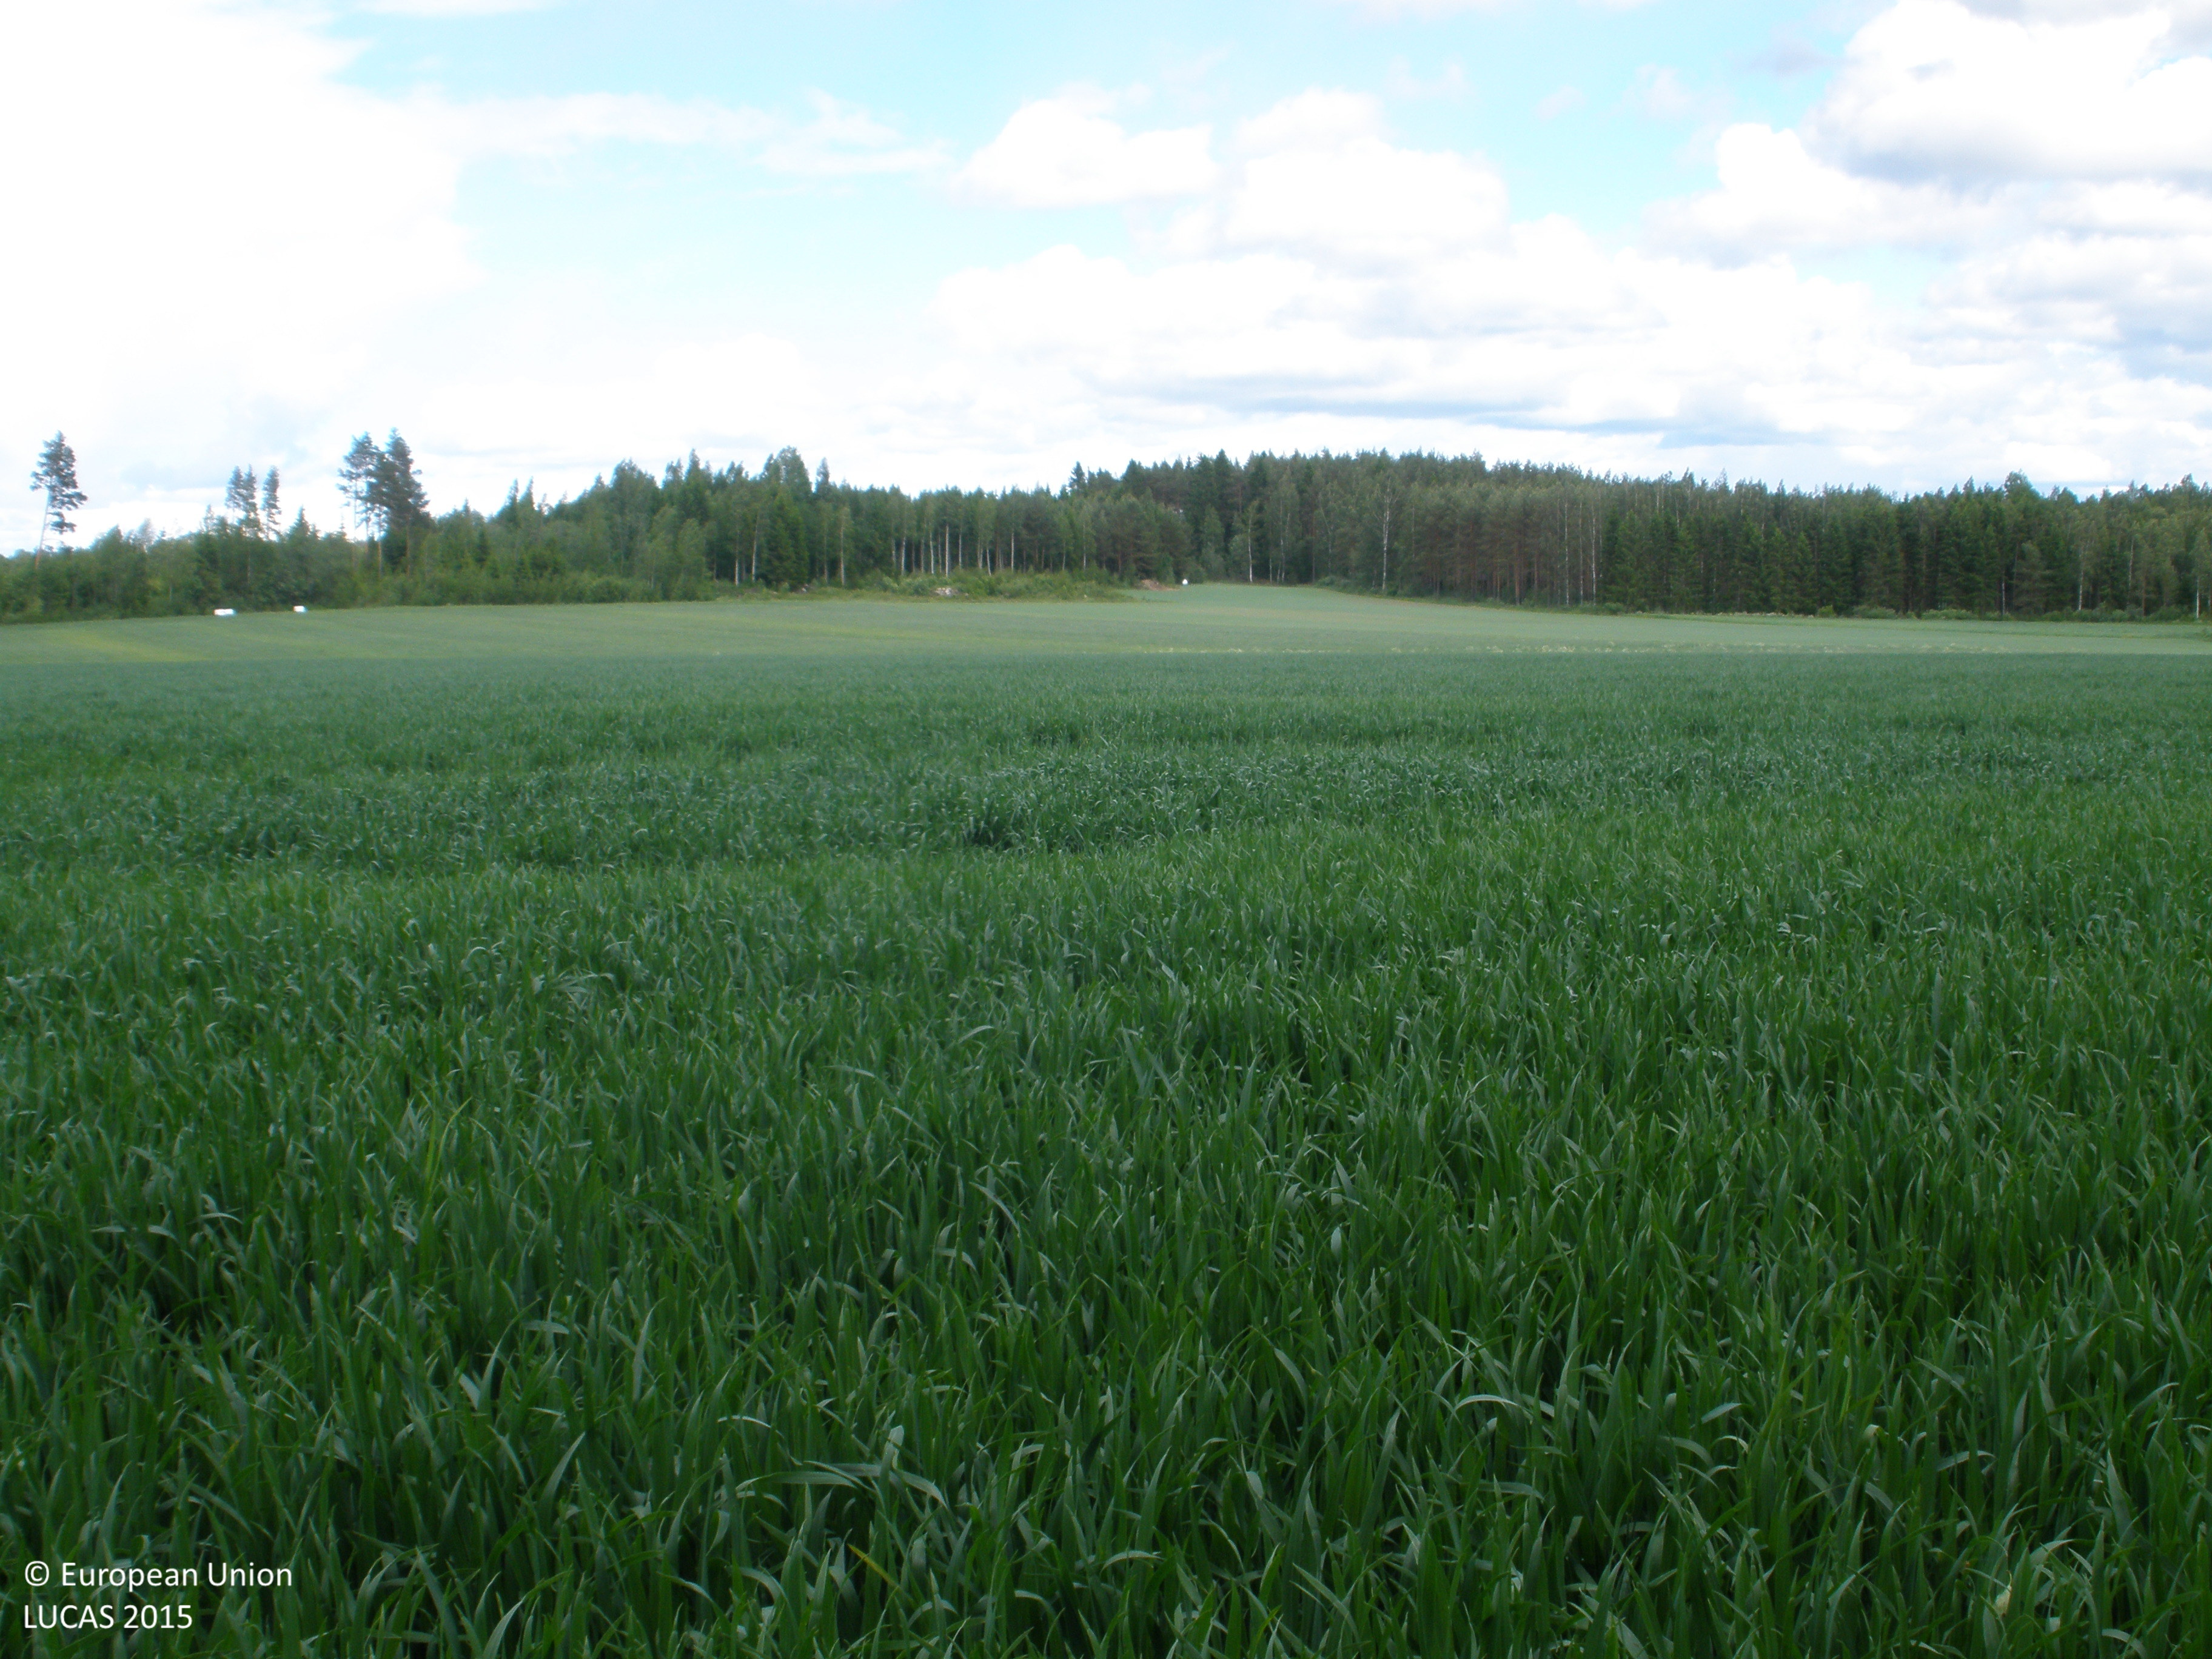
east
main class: Cropland
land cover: Common wheat
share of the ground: > 75 %
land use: Agriculture (excluding fallow land and kitchen gardens)
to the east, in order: Common wheat; Grass margins; Ditches and canals; Grass margins; Arable land (only in case pi)
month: June
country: FI
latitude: 61.1090
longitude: 24.5568
